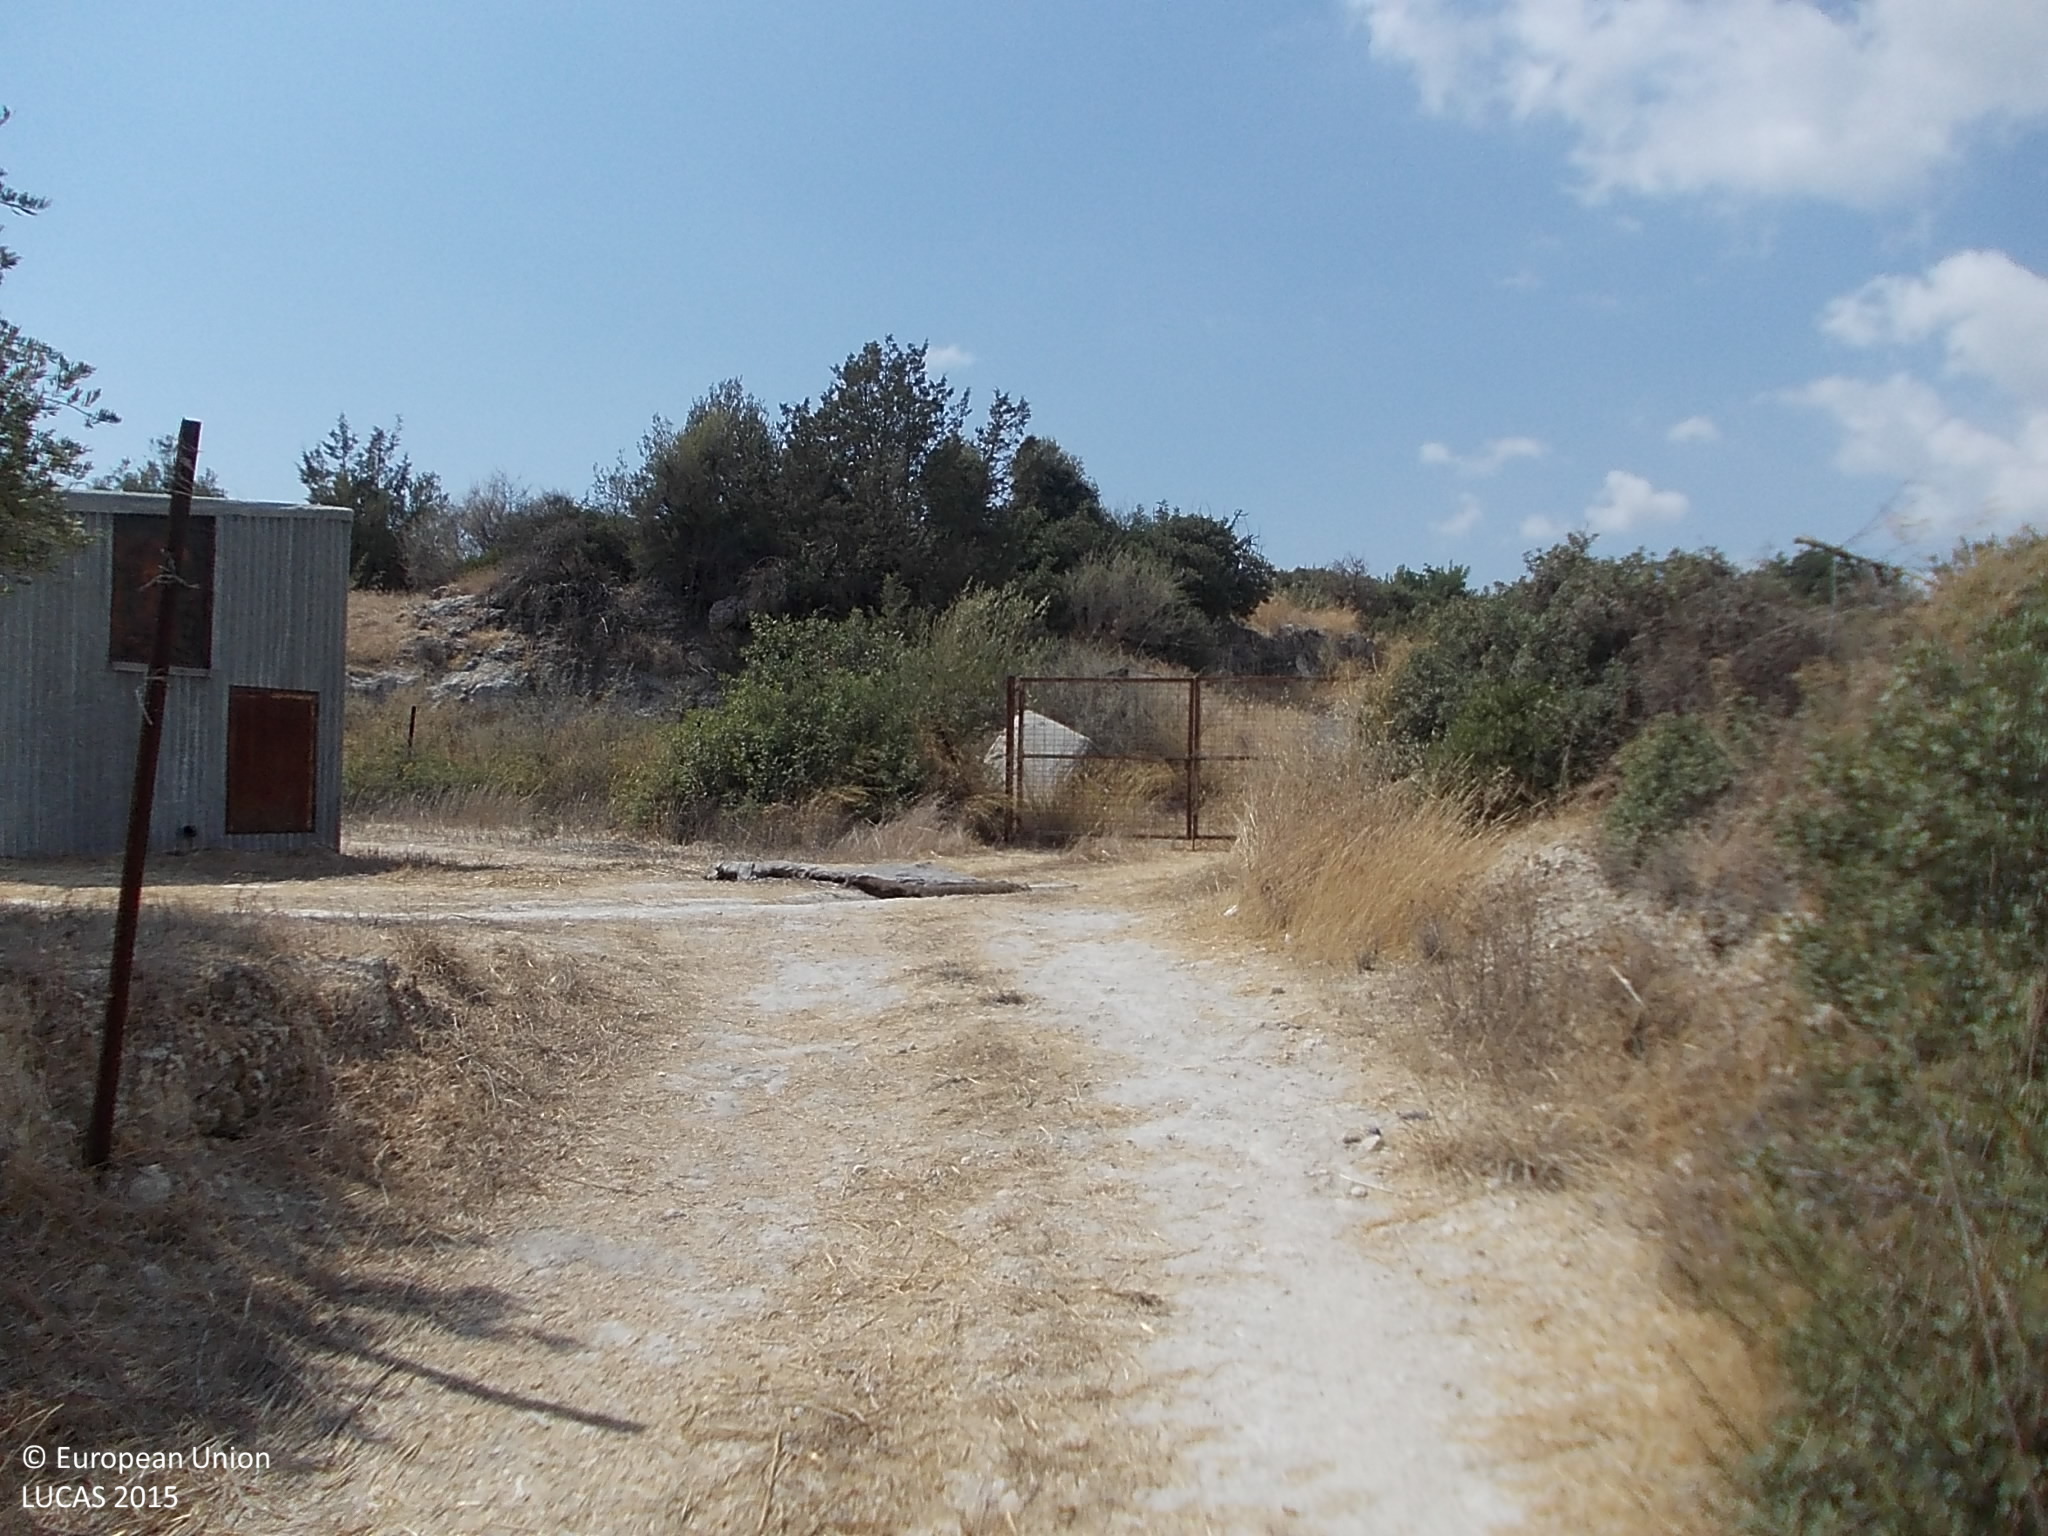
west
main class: Shrubland
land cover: Shrubland without tree cover
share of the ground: > 75 %
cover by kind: shrubs 95 %, herbaceous plants 5 %
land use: Semi-natural and natural areas not in use
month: May
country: CY
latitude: 34.6811
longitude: 32.7807
